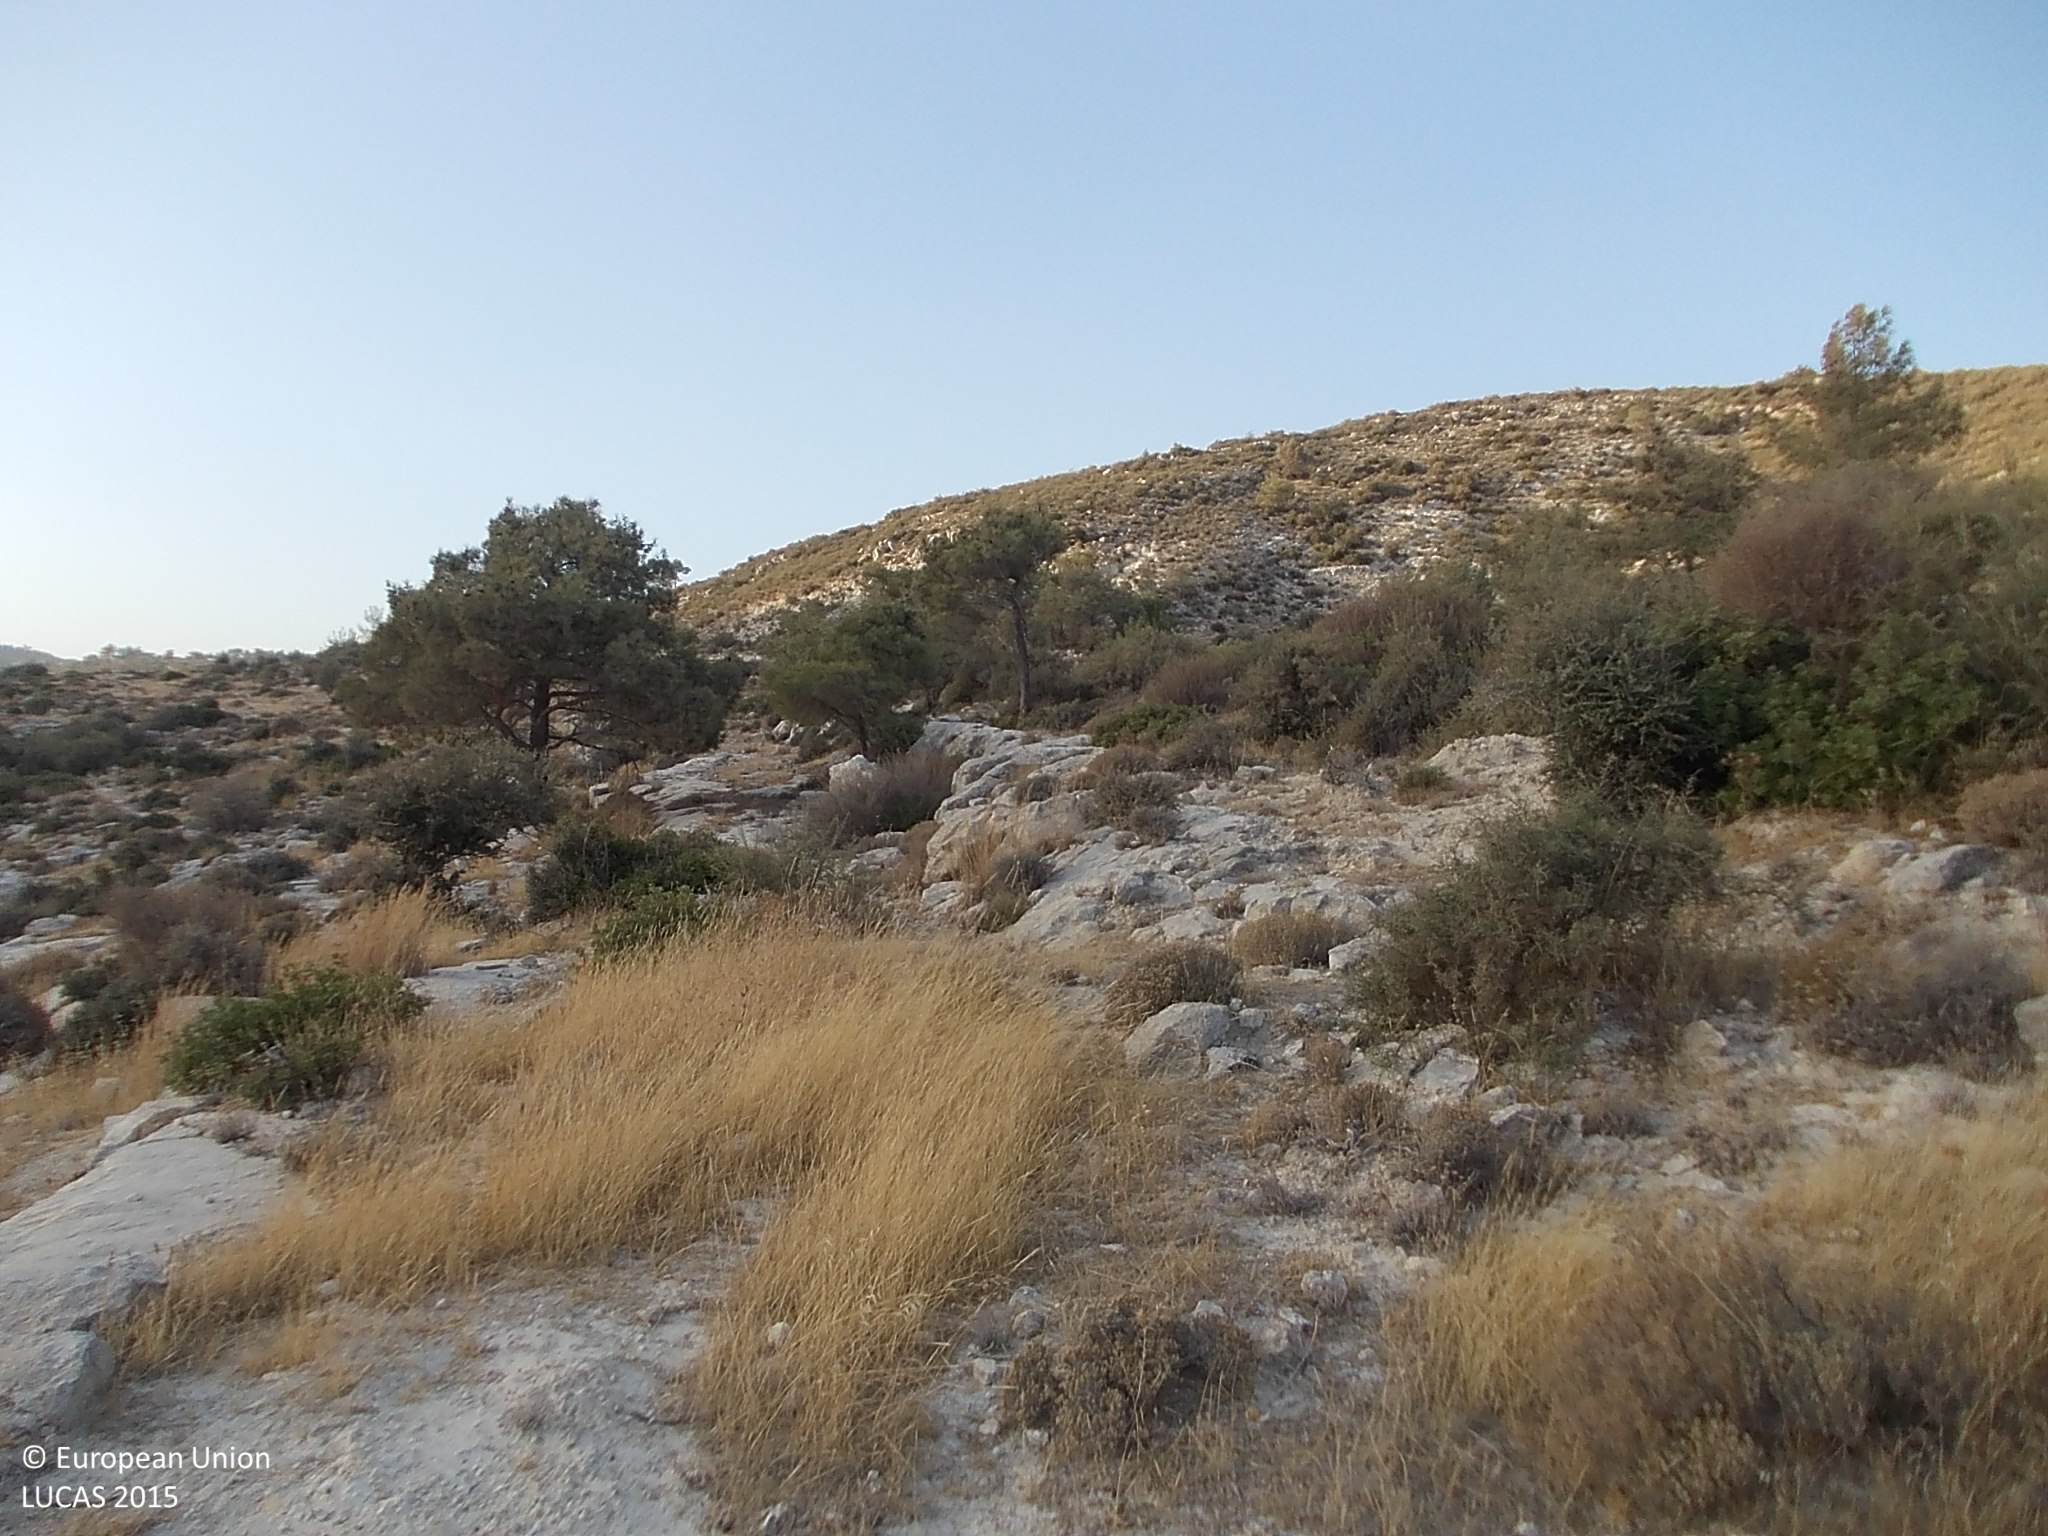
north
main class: Shrubland
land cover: Shrubland without tree cover
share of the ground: 50 - 75 %
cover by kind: shrubs 60 %, consolidated bare surface 20 %, herbaceous plants 10 %, unconsolidated bare surface 10 %
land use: Semi-natural and natural areas not in use
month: September
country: CY
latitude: 34.7064
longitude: 32.9022
